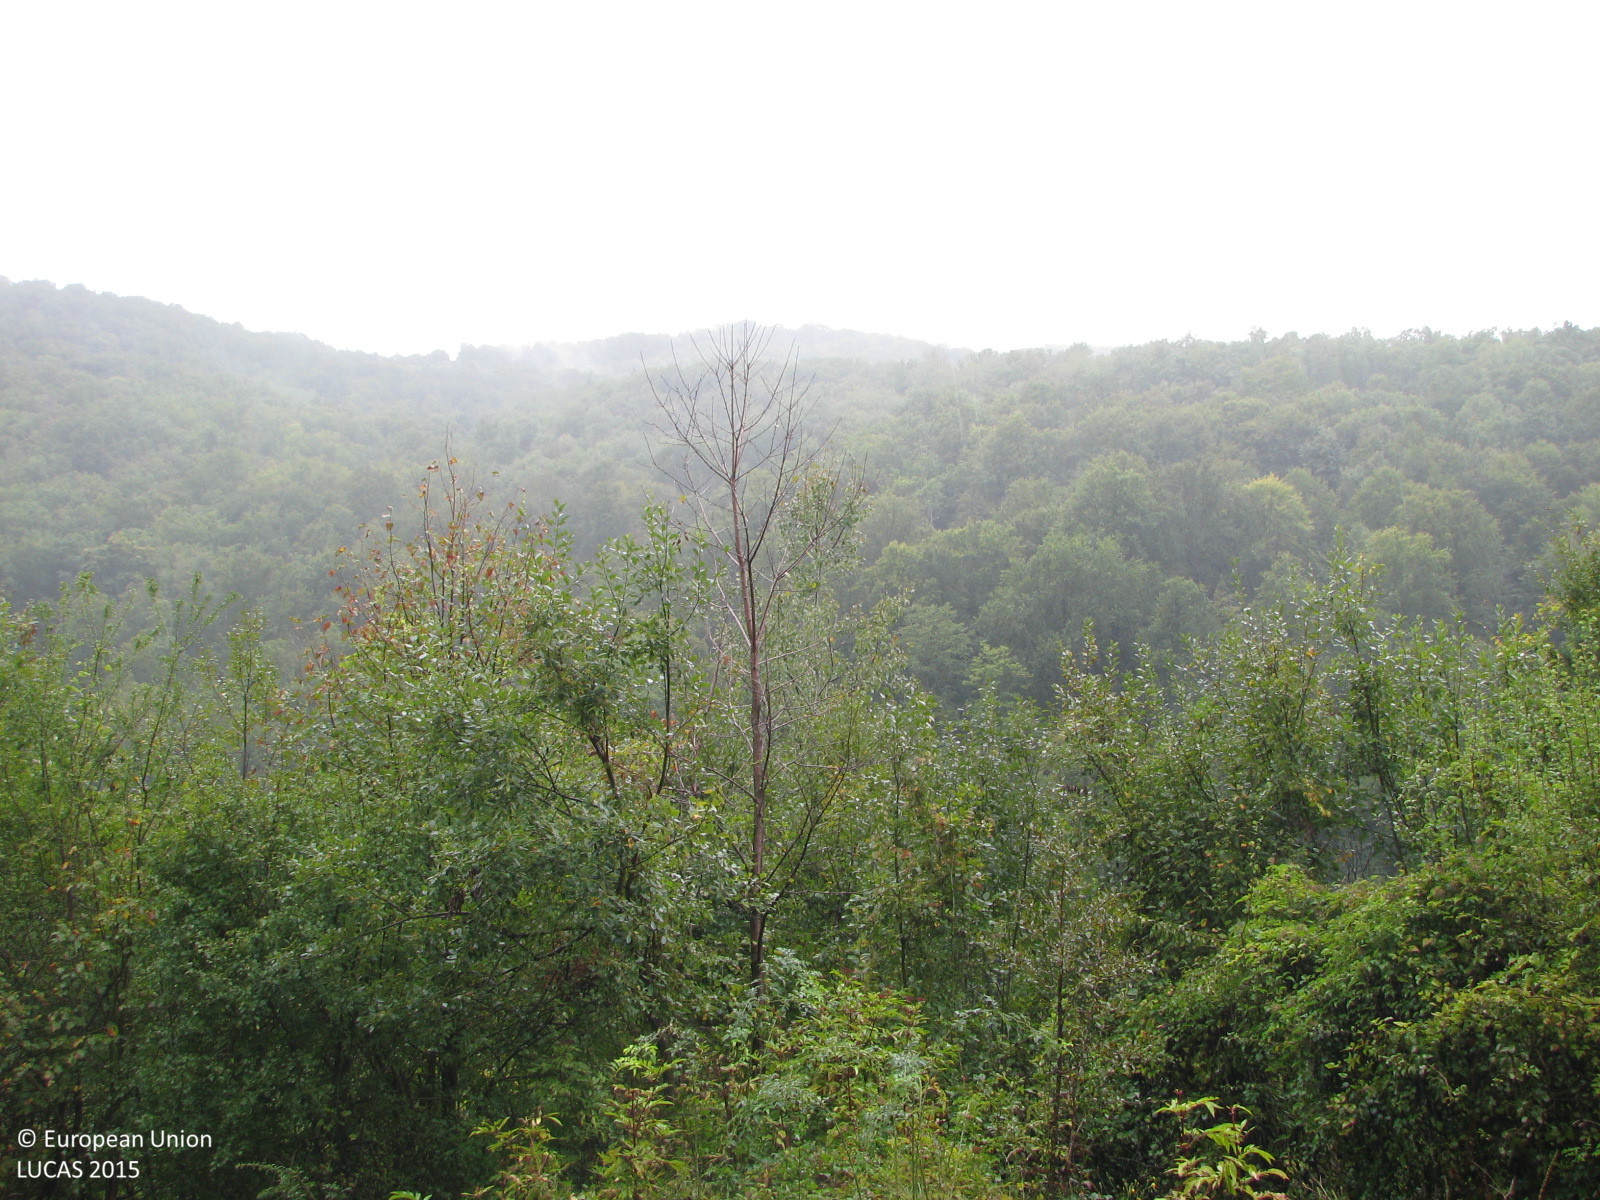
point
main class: Woodland
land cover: Broadleaved woodland
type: mesophytic deciduous forest
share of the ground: > 75 %
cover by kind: broadleaved forest trees 100 %
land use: Forestry
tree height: > 5 m
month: September
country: BG
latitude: 42.9633
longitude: 26.3883
